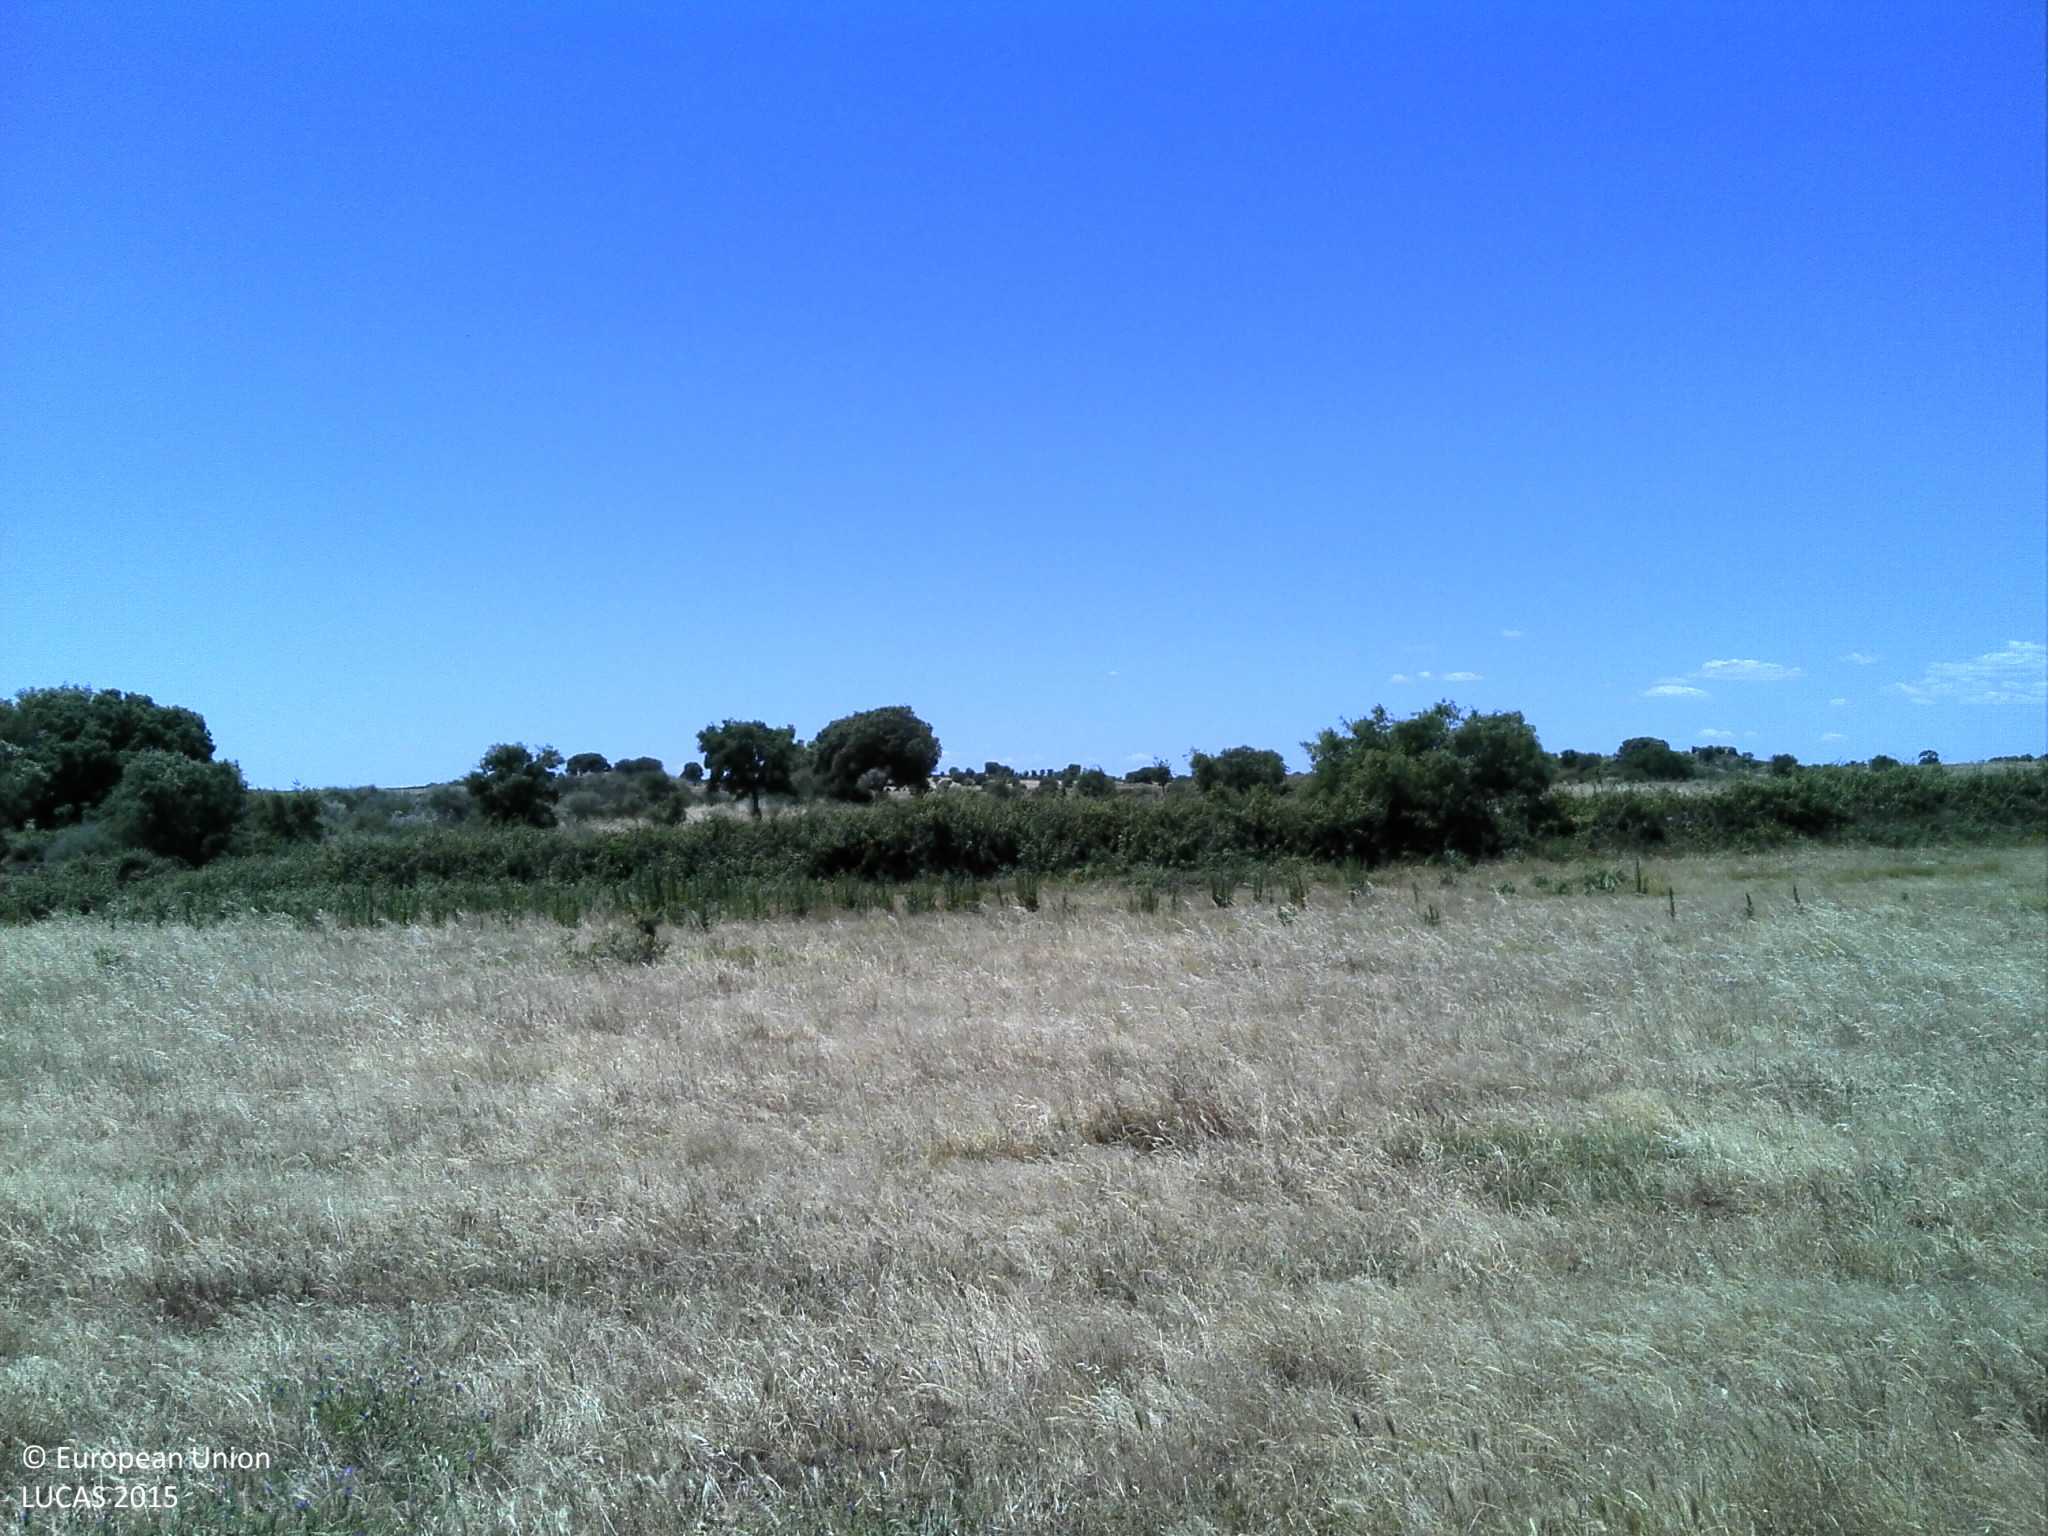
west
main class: Grassland
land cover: Grassland without tree/shrub cover
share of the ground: 50 - 75 %
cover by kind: herbaceous plants 75 %, unconsolidated bare surface 25 %
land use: Agriculture (excluding fallow land and kitchen gardens)
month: May
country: PT
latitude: 39.4462
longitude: -7.6539
